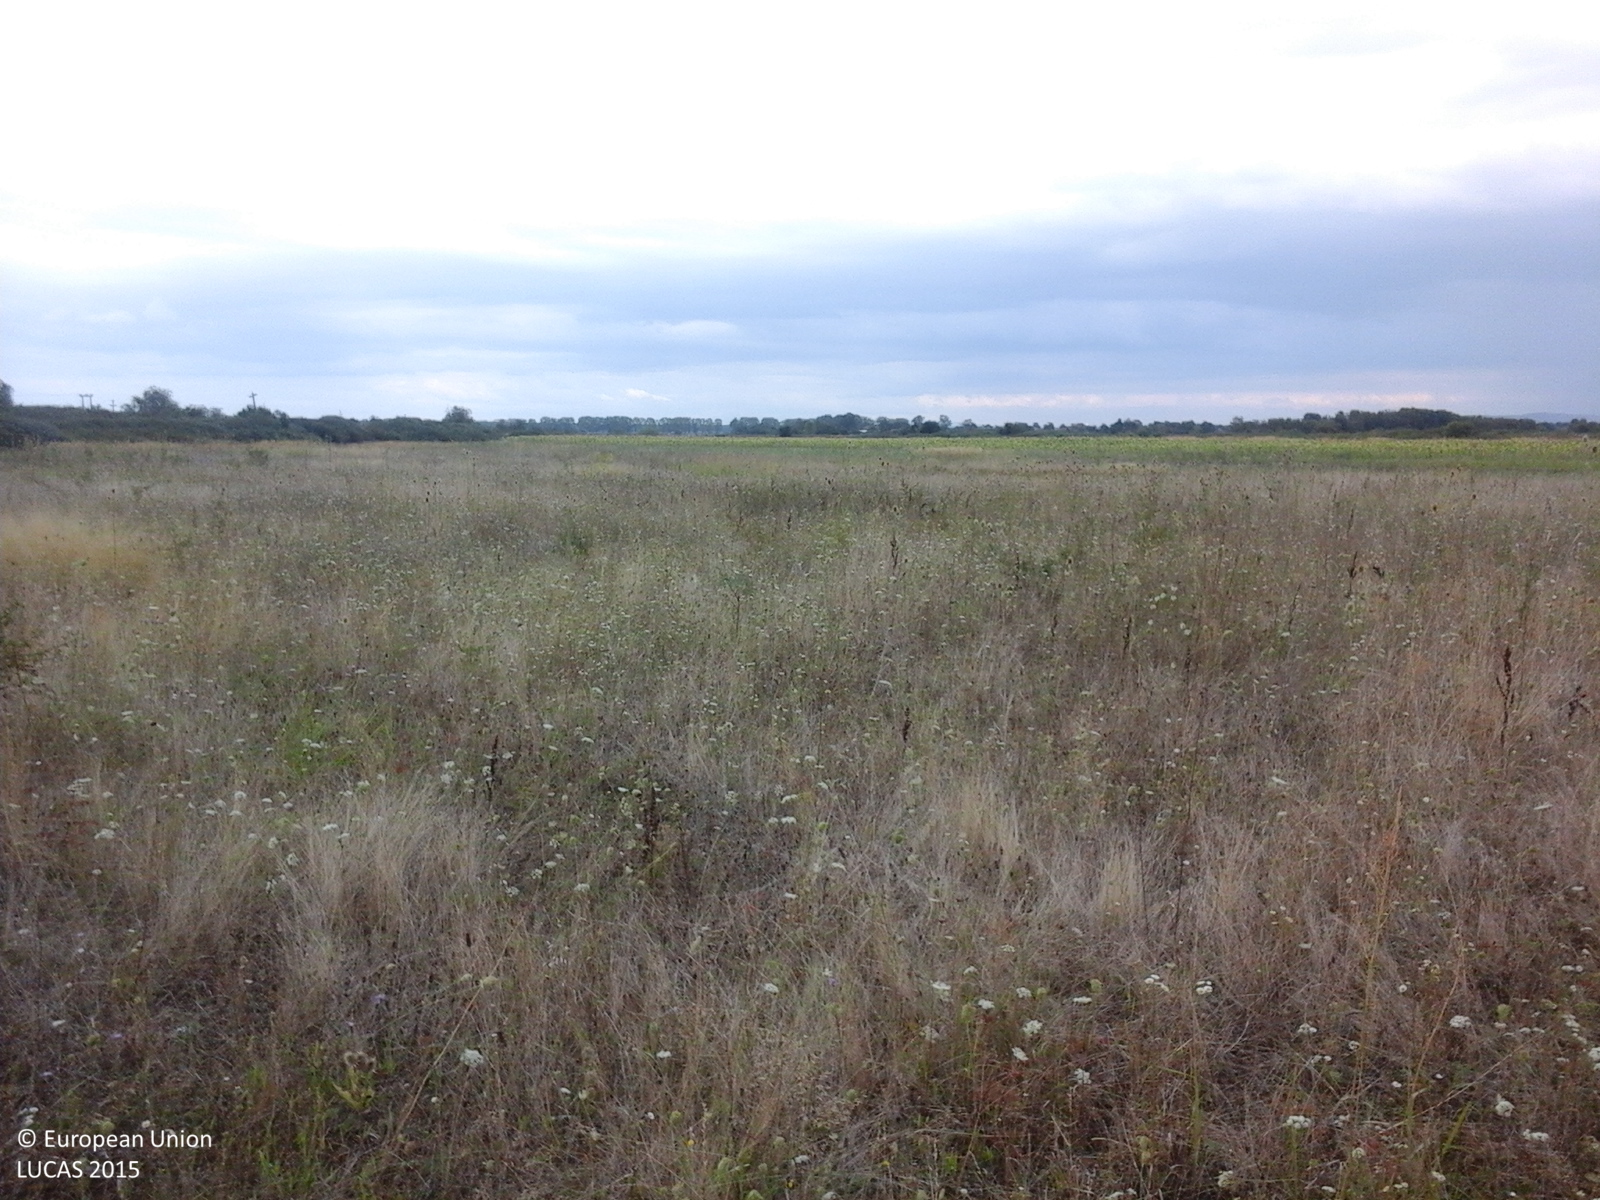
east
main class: Grassland
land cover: Grassland without tree/shrub cover
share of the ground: > 75 %
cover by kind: herbaceous plants 100 %
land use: Agriculture (excluding fallow land and kitchen gardens)
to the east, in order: Grassland without tree/shrub cover; Spontaneously vegetated surfaces; Sunflower; Grassland without tree/shrub cover
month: August
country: RO
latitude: 45.6772
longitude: 21.4716
